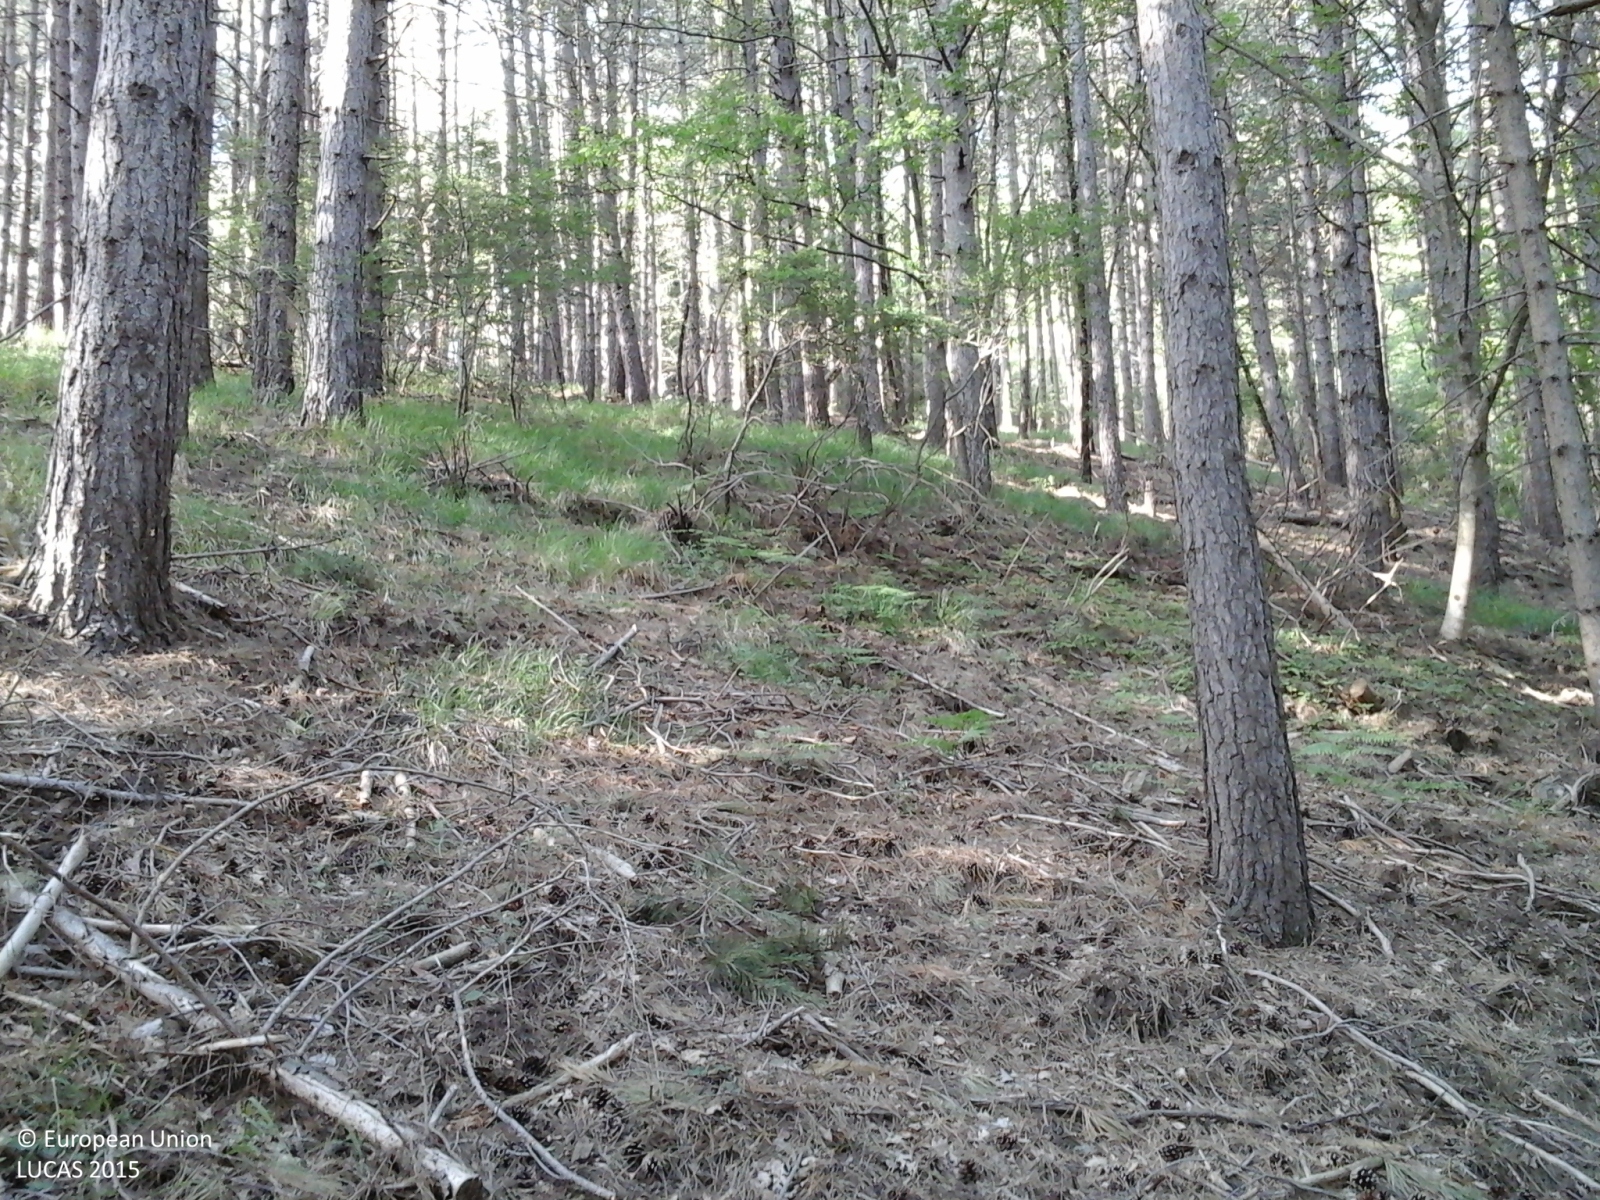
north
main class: Woodland
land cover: Pine dominated coniferous woodland
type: alpine coniferous forest
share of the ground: > 75 %
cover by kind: coniferous forest trees 100 %
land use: Forestry
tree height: > 5 m
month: May
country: IT
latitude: 43.7616
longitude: 11.5486
